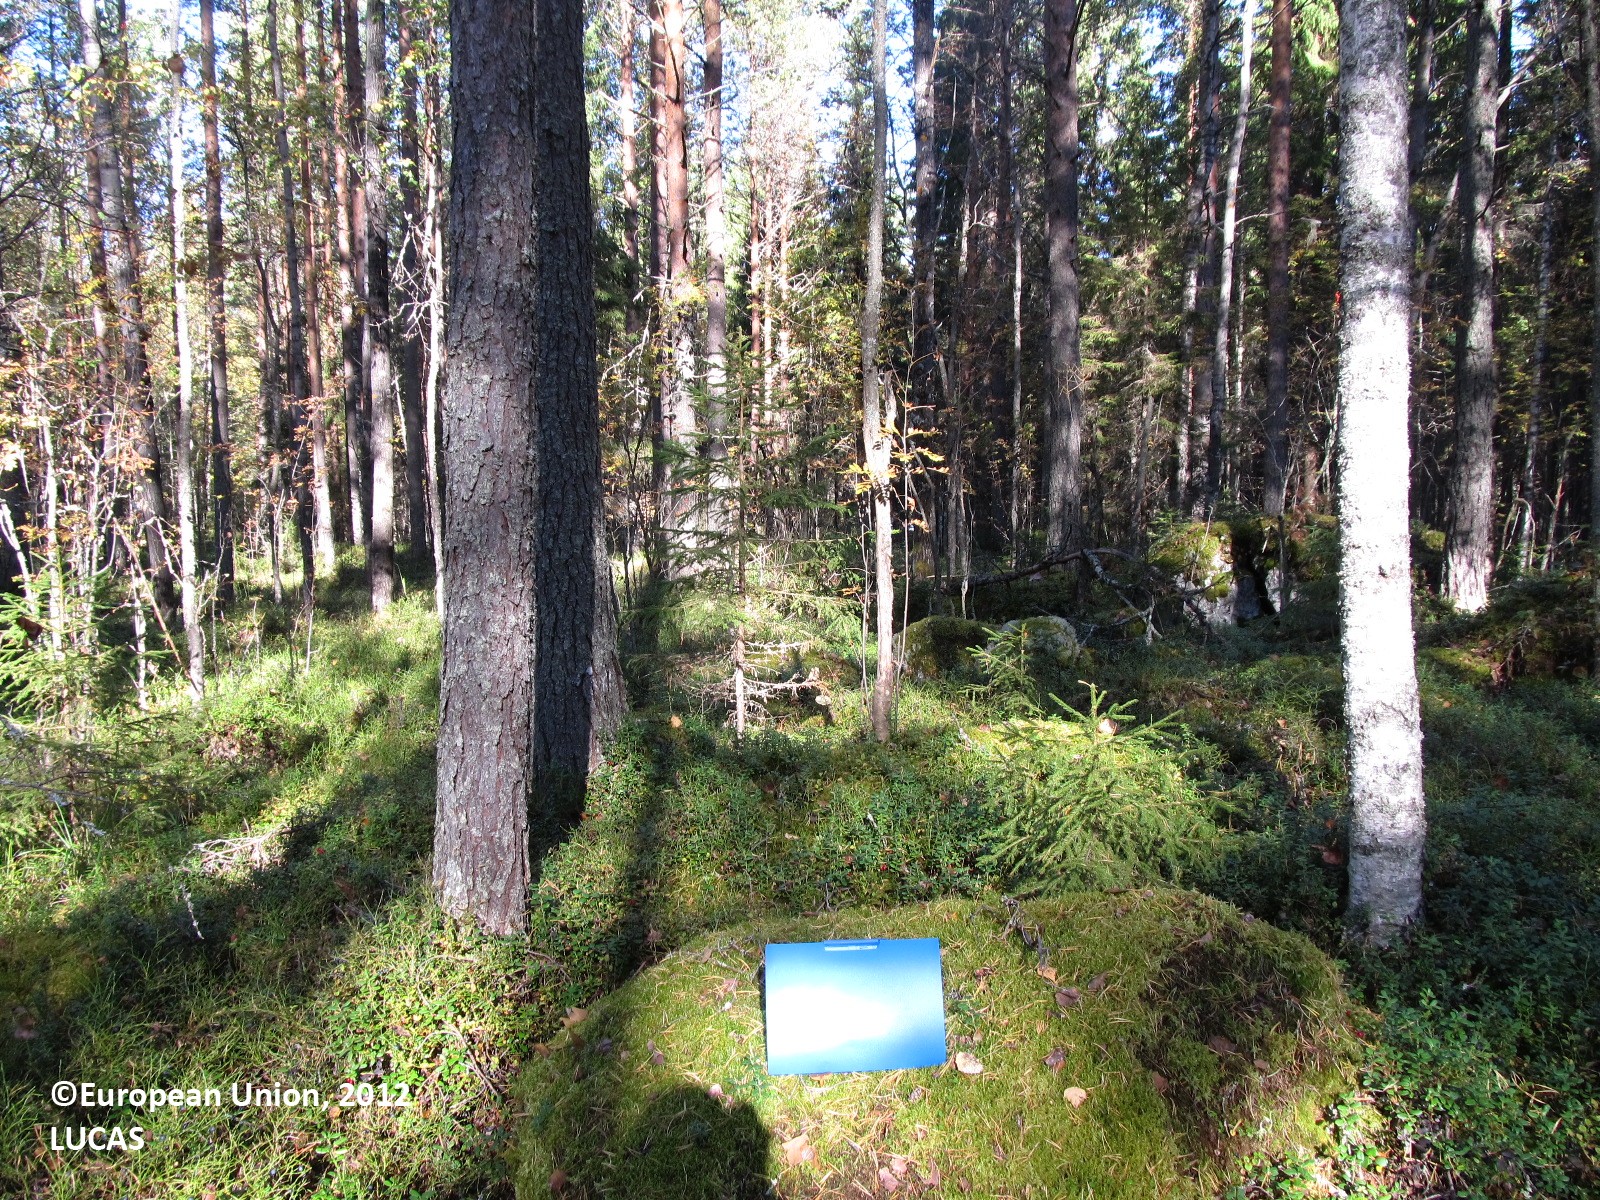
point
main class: Woodland
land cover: Pine dominated coniferous woodland
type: boreal forest
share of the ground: 25 - 50 %
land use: Forestry
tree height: > 5 m
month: September
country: FI
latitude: 62.4897
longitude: 28.2194
